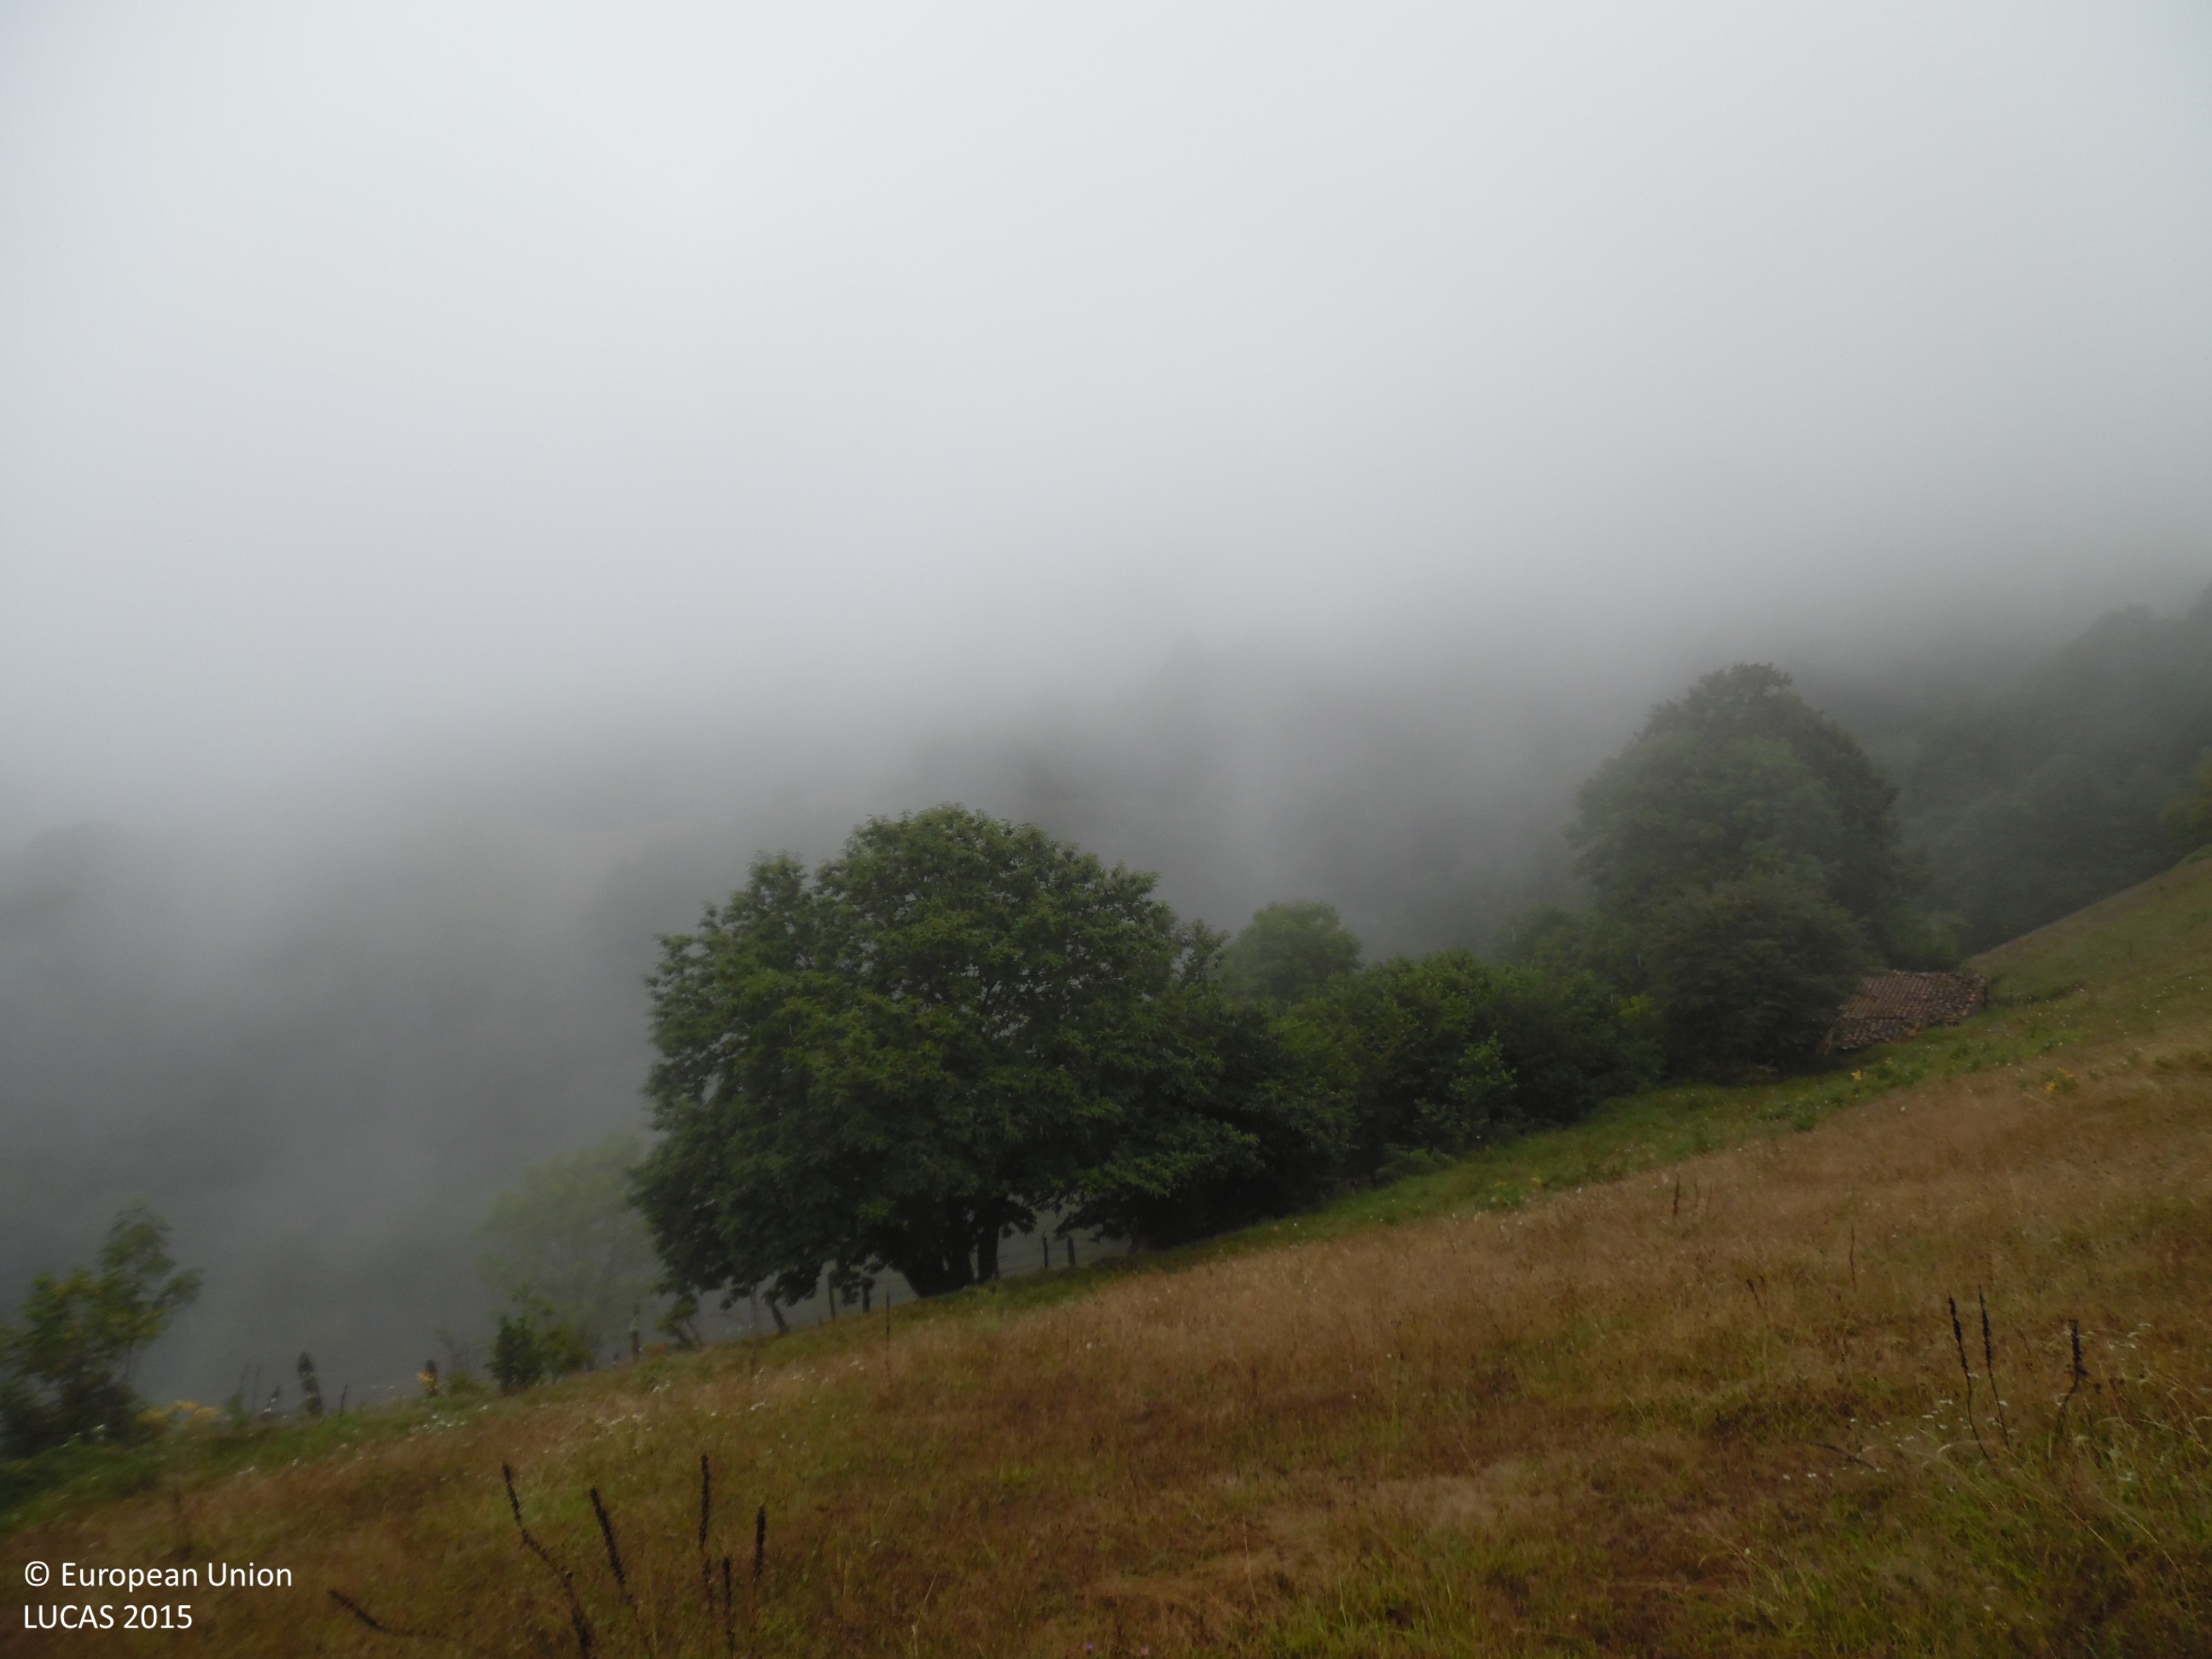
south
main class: Grassland
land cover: Grassland without tree/shrub cover
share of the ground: > 75 %
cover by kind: herbaceous plants 100 %
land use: Agriculture (excluding fallow land and kitchen gardens)
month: July
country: ES
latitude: 43.1361
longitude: -5.8835
